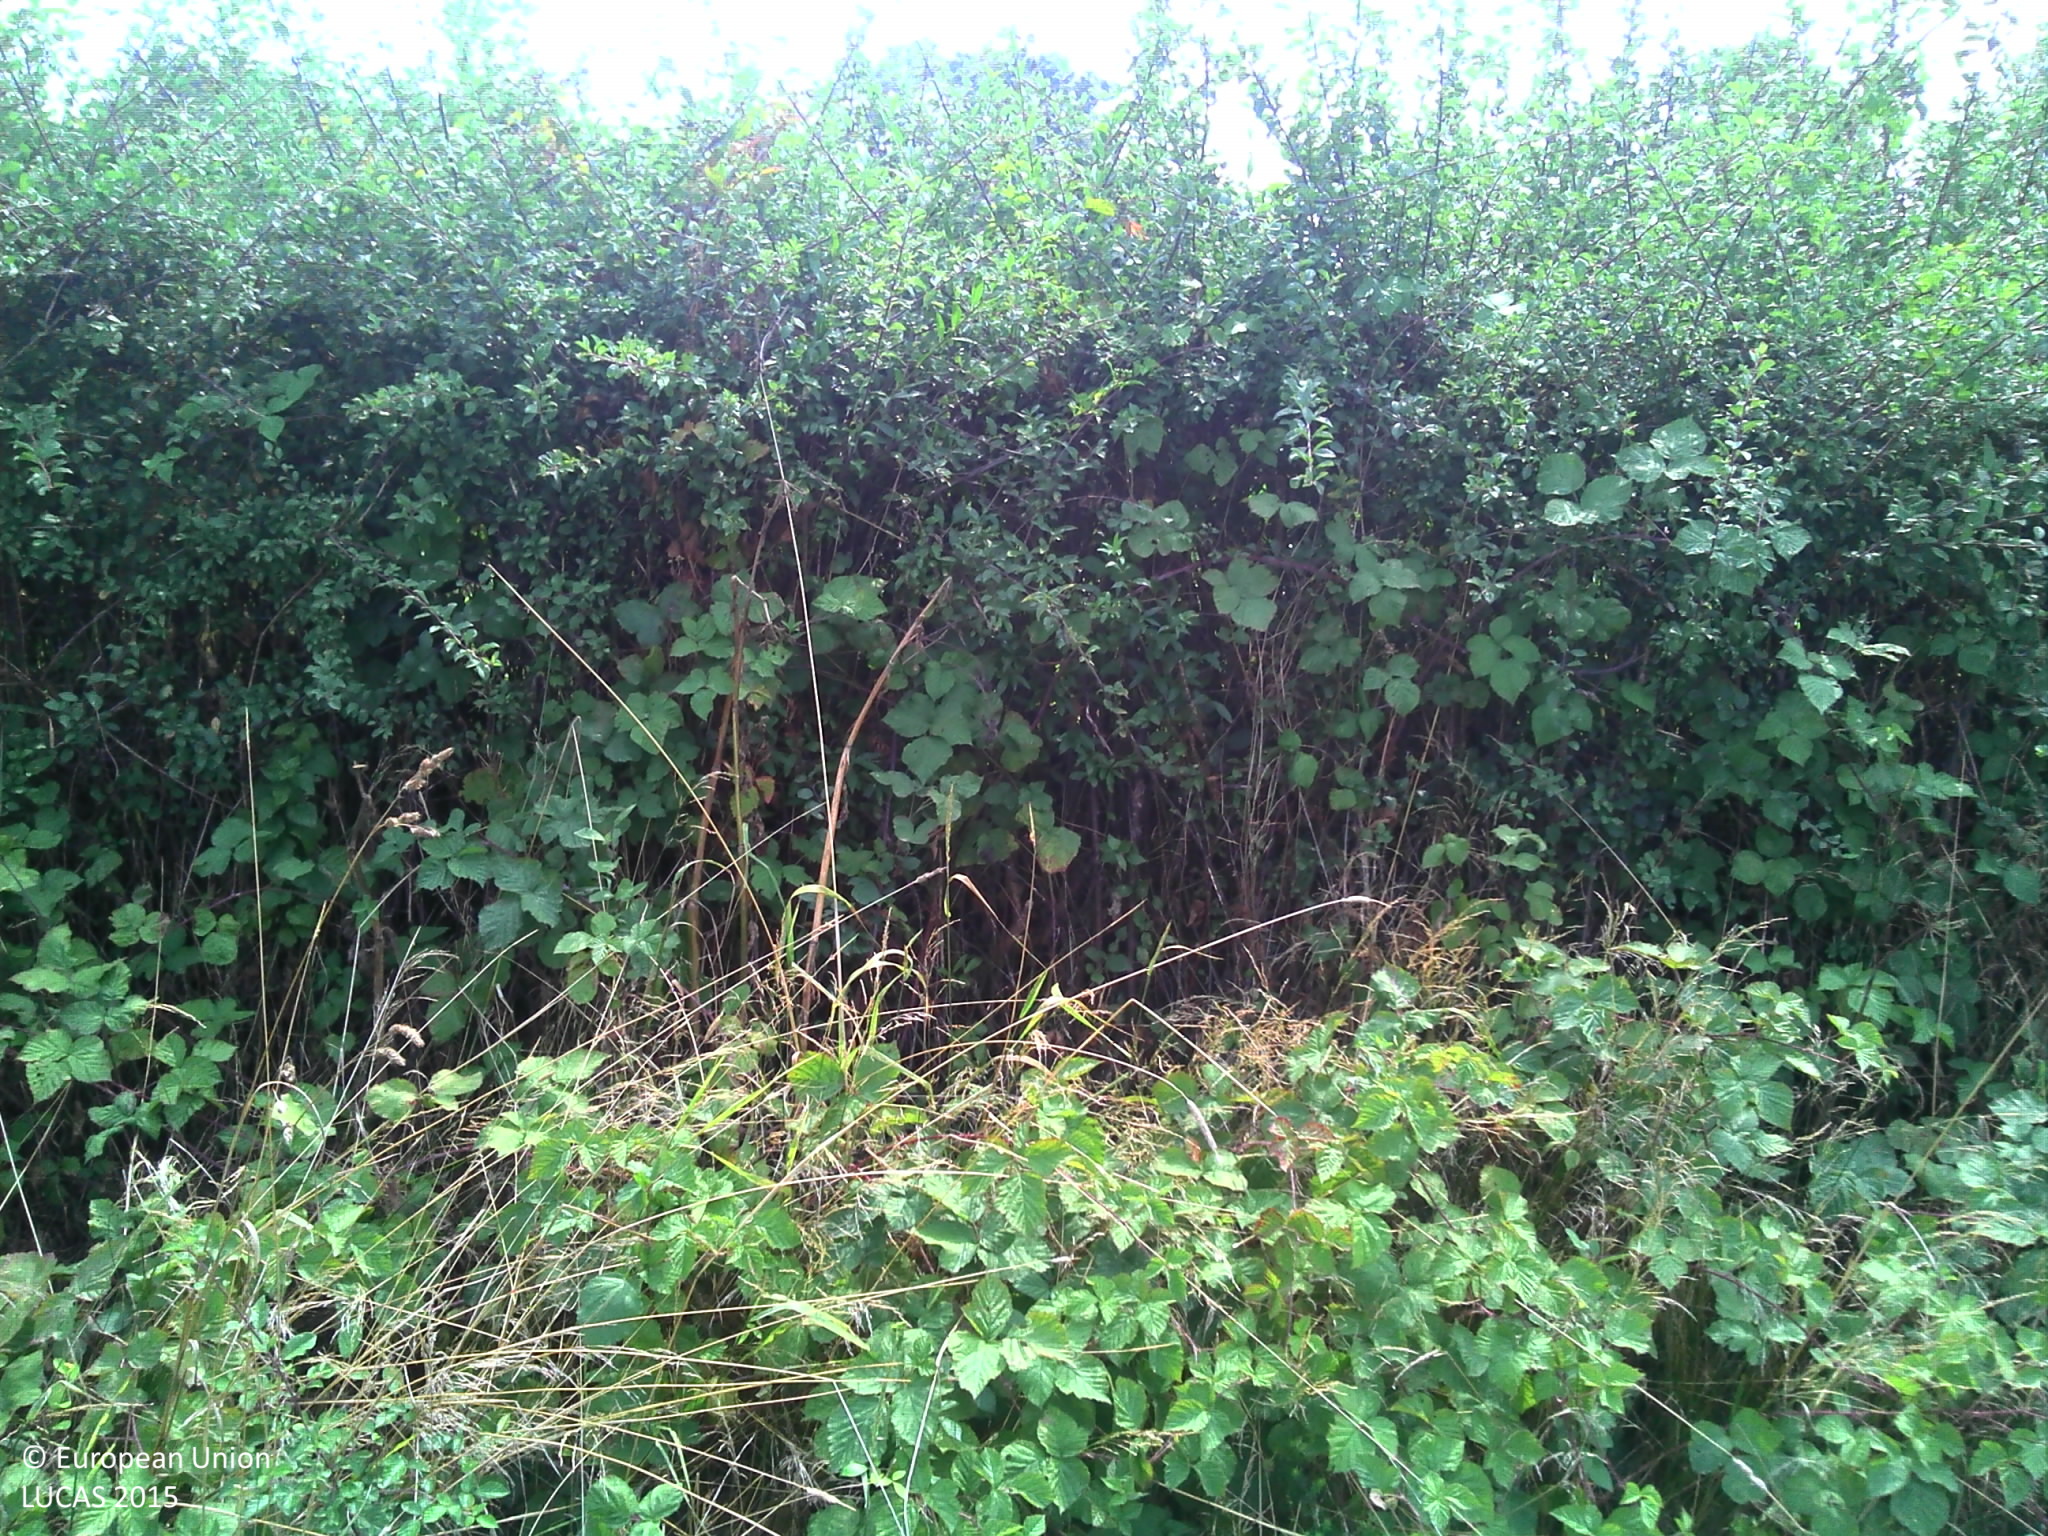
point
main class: Grassland
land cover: Grassland without tree/shrub cover
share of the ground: > 75 %
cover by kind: herbaceous plants 100 %
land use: Agriculture (excluding fallow land and kitchen gardens)
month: August
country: FR
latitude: 46.3055
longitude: 3.6246
